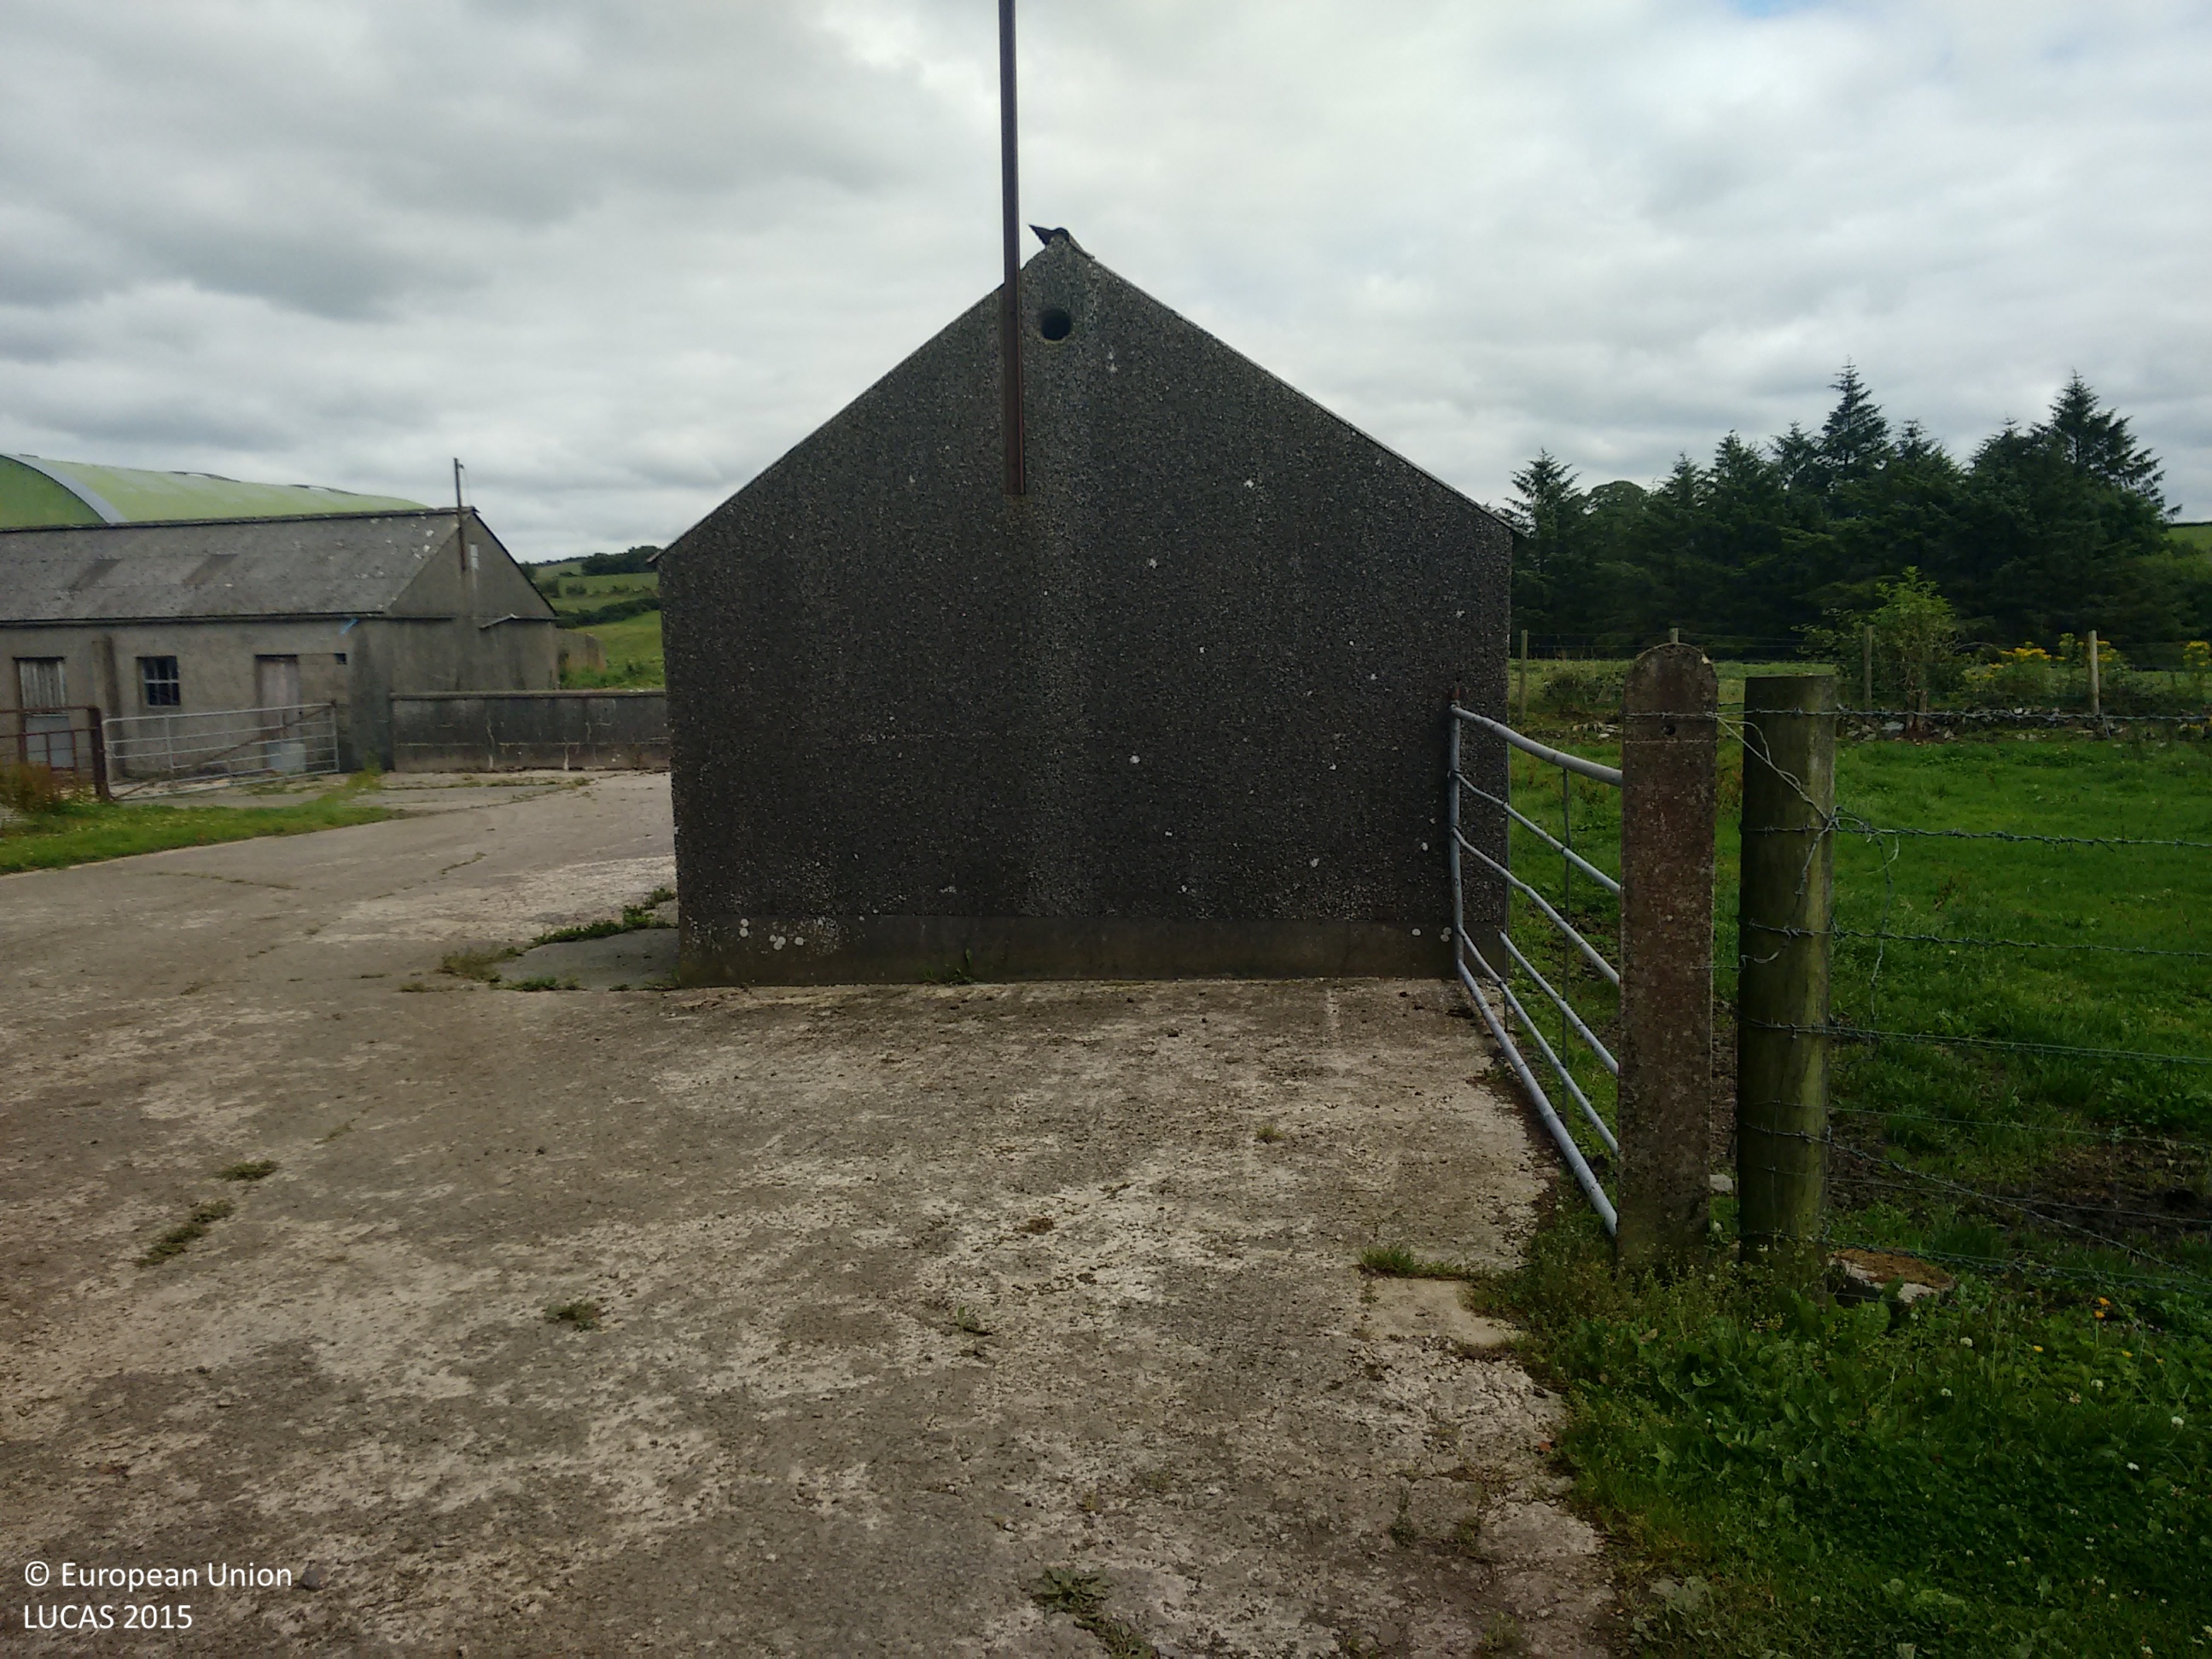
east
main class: Grassland
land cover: Grassland without tree/shrub cover
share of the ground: > 75 %
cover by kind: herbaceous plants 100 %
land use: Agriculture (excluding fallow land and kitchen gardens)
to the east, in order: Grassland without tree/shrub cover; Single bushes/trees; Grassland without tree/shrub cover; Single bushes/trees; Grassland without tree/shrub cover; Fences; Managed hedges; Grassland without tree/shrub cover; Fences; Artificial constructions in urban areas; Managed hedges; Grassland without tree/shrub cover; Artificial constructions in urban areas; Grassland without tree/shrub cover; Abandoned hedges; Grassland without tree/shrub cover
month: August
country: GB
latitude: 54.1712
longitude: -6.6271
